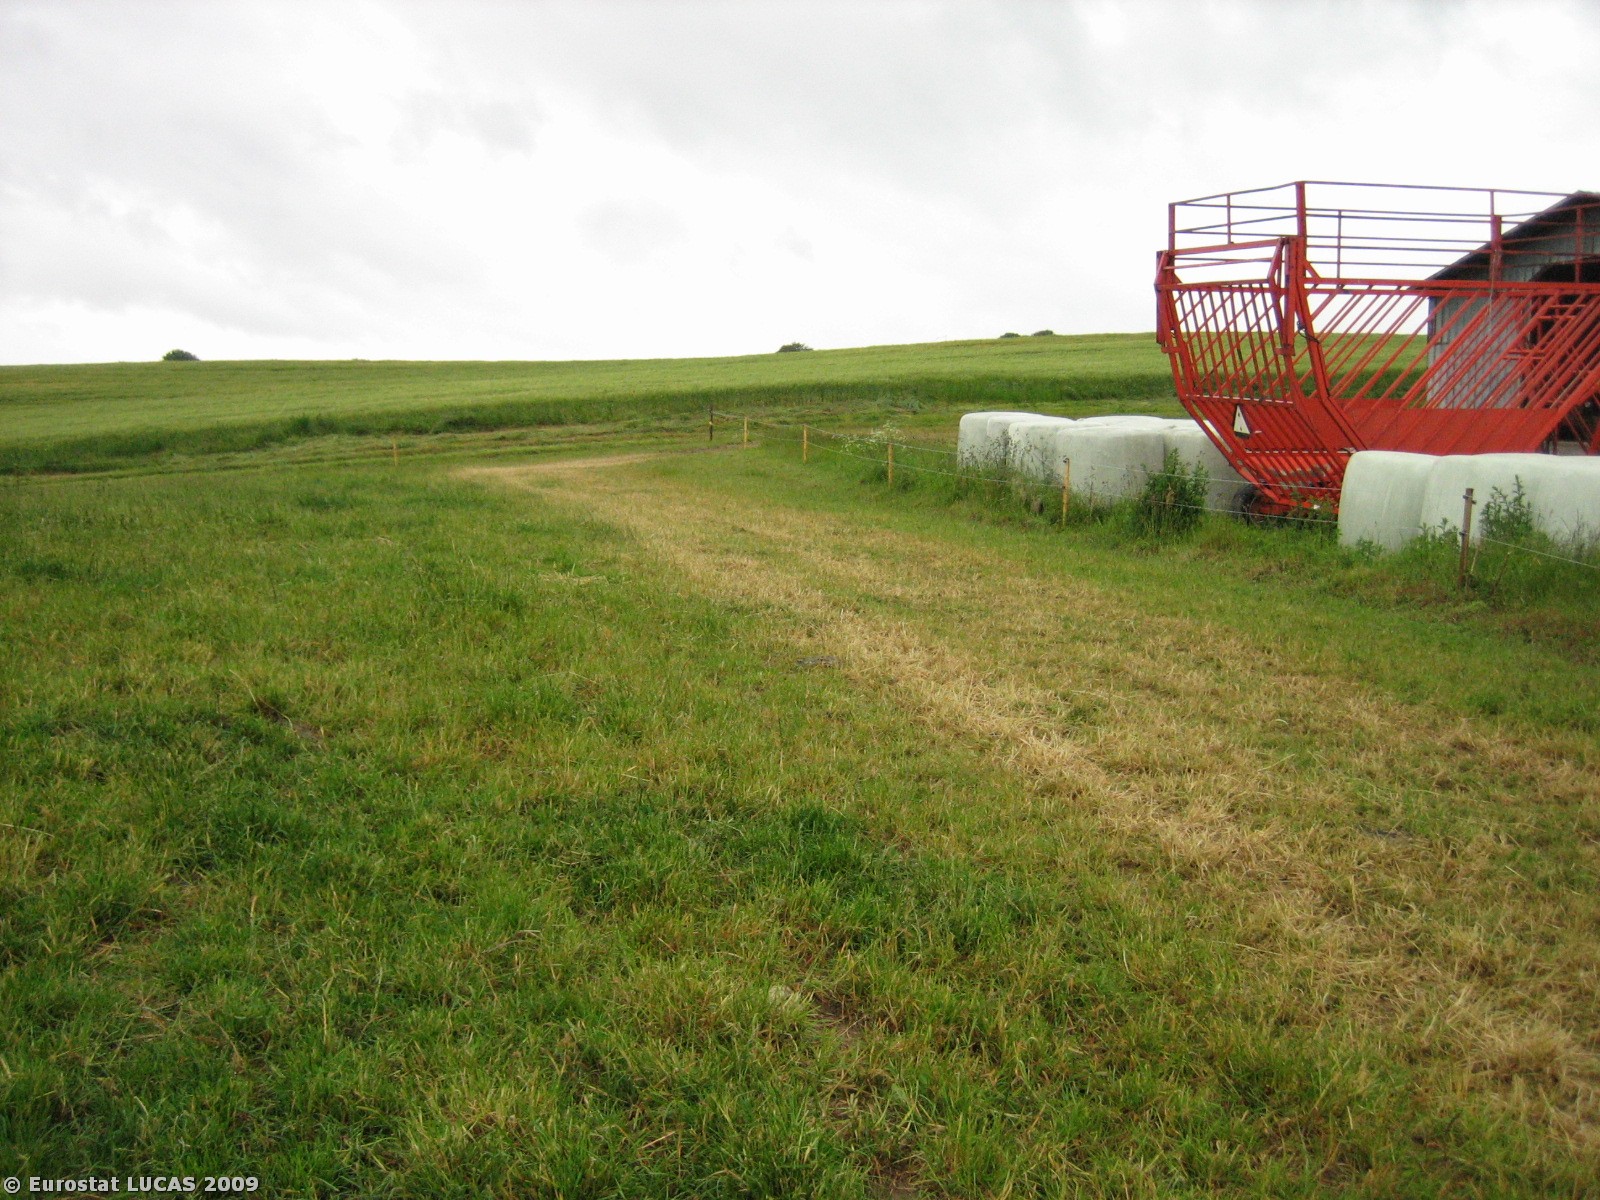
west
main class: Grassland
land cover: Grassland without tree/shrub cover
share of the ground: 50 - 75 %
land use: Agriculture (excluding fallow land and kitchen gardens)
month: June
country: DK
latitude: 56.0799
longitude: 9.9840
